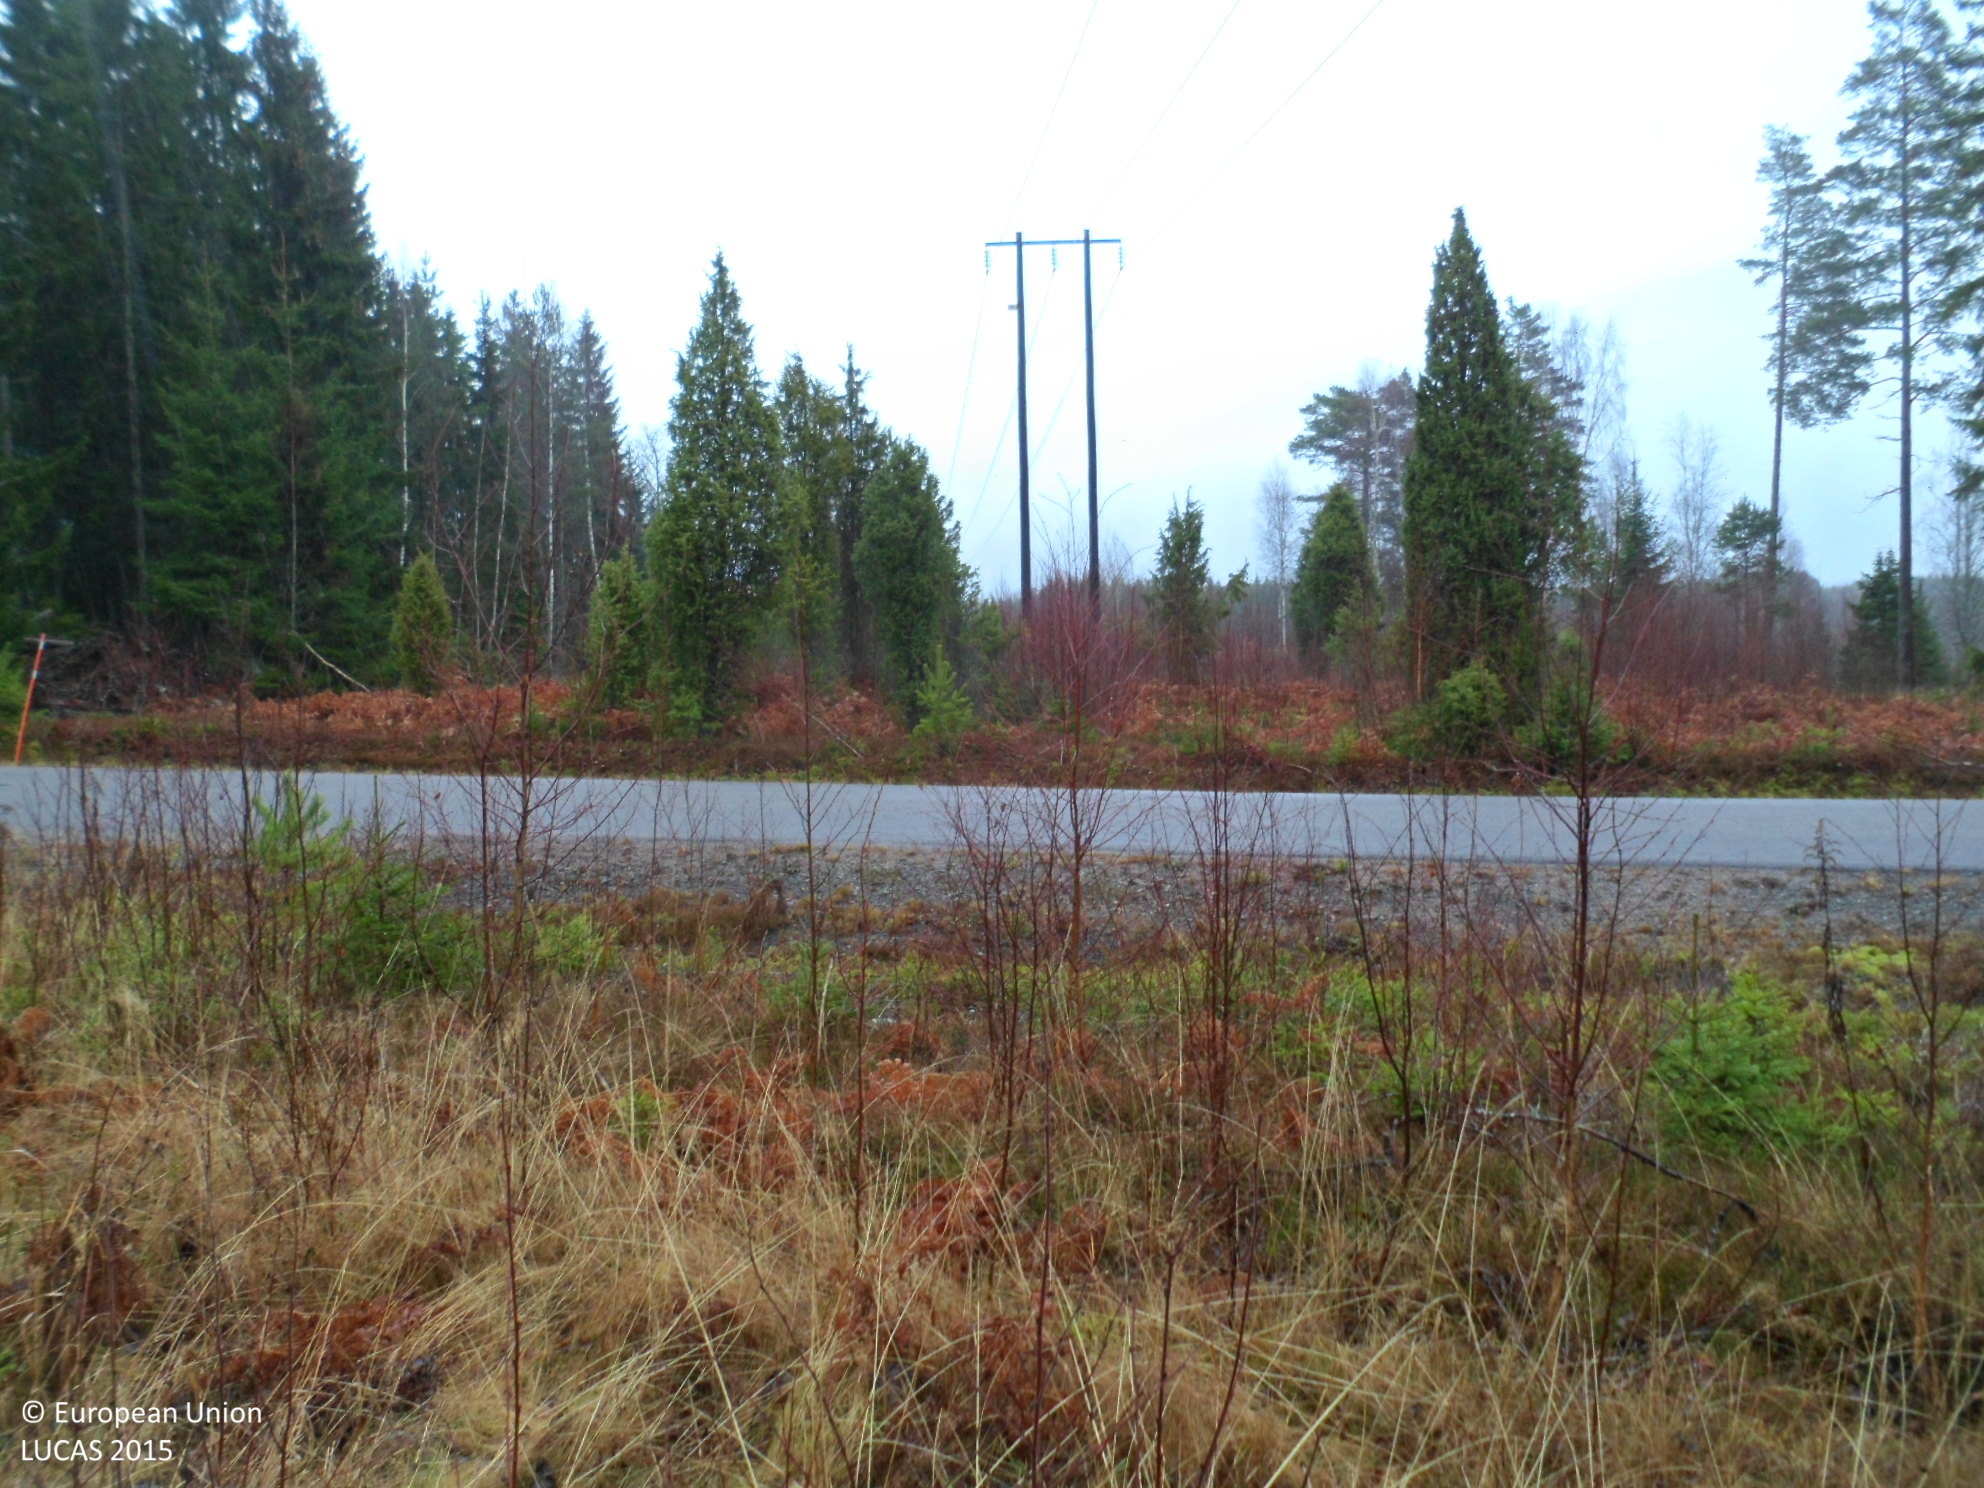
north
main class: Woodland
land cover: Broadleaved woodland
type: boreal forest
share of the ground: 50 - 75 %
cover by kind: broadleaved forest trees 55 %, herbaceous plants 30 %, shrubs 15 %
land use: Electricity, gas and thermal power distribution
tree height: < 5 m
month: November
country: SE
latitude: 57.7560
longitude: 14.7848
